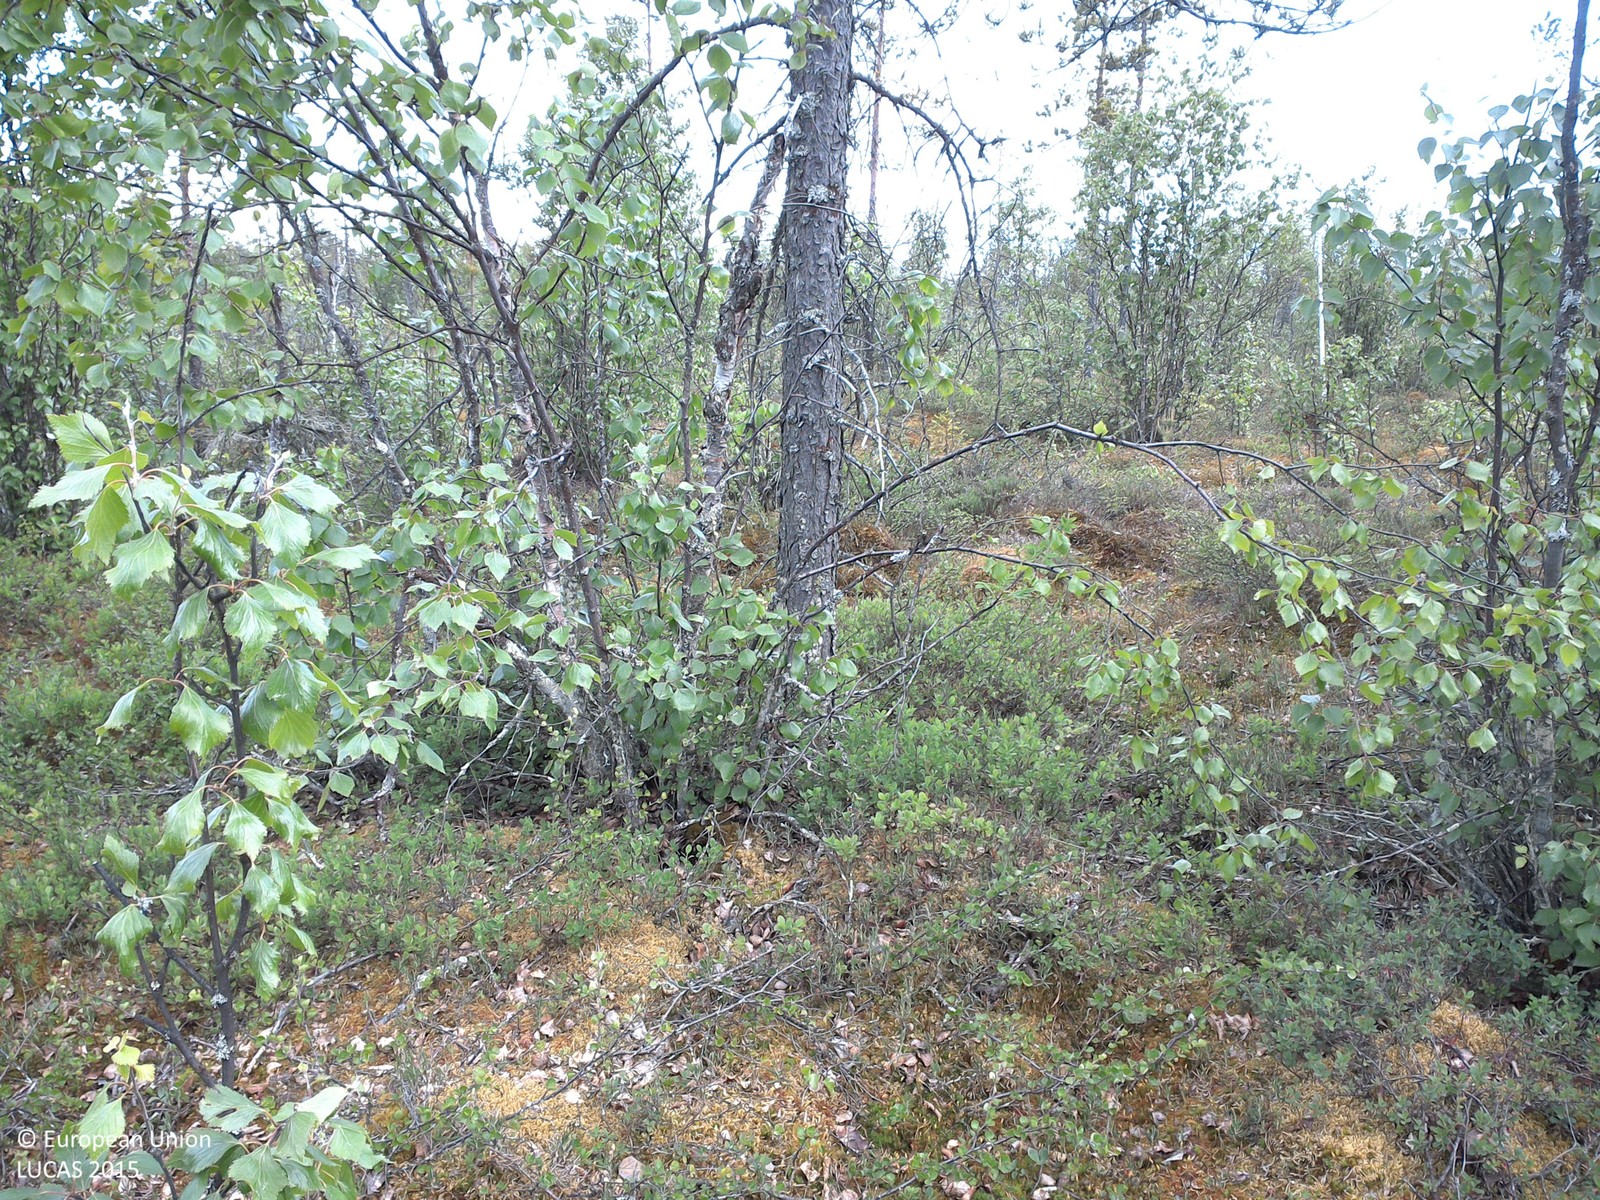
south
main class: Woodland
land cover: Other mixed woodland
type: boreal forest
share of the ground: 10 - 25 %
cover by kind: lichens and mosses 45 %, shrubs 35 %, coniferous forest trees 10 %, broadleaved forest trees 10 %
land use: Forestry
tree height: < 5 m
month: July
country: SE
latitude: 67.2439
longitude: 23.2444
